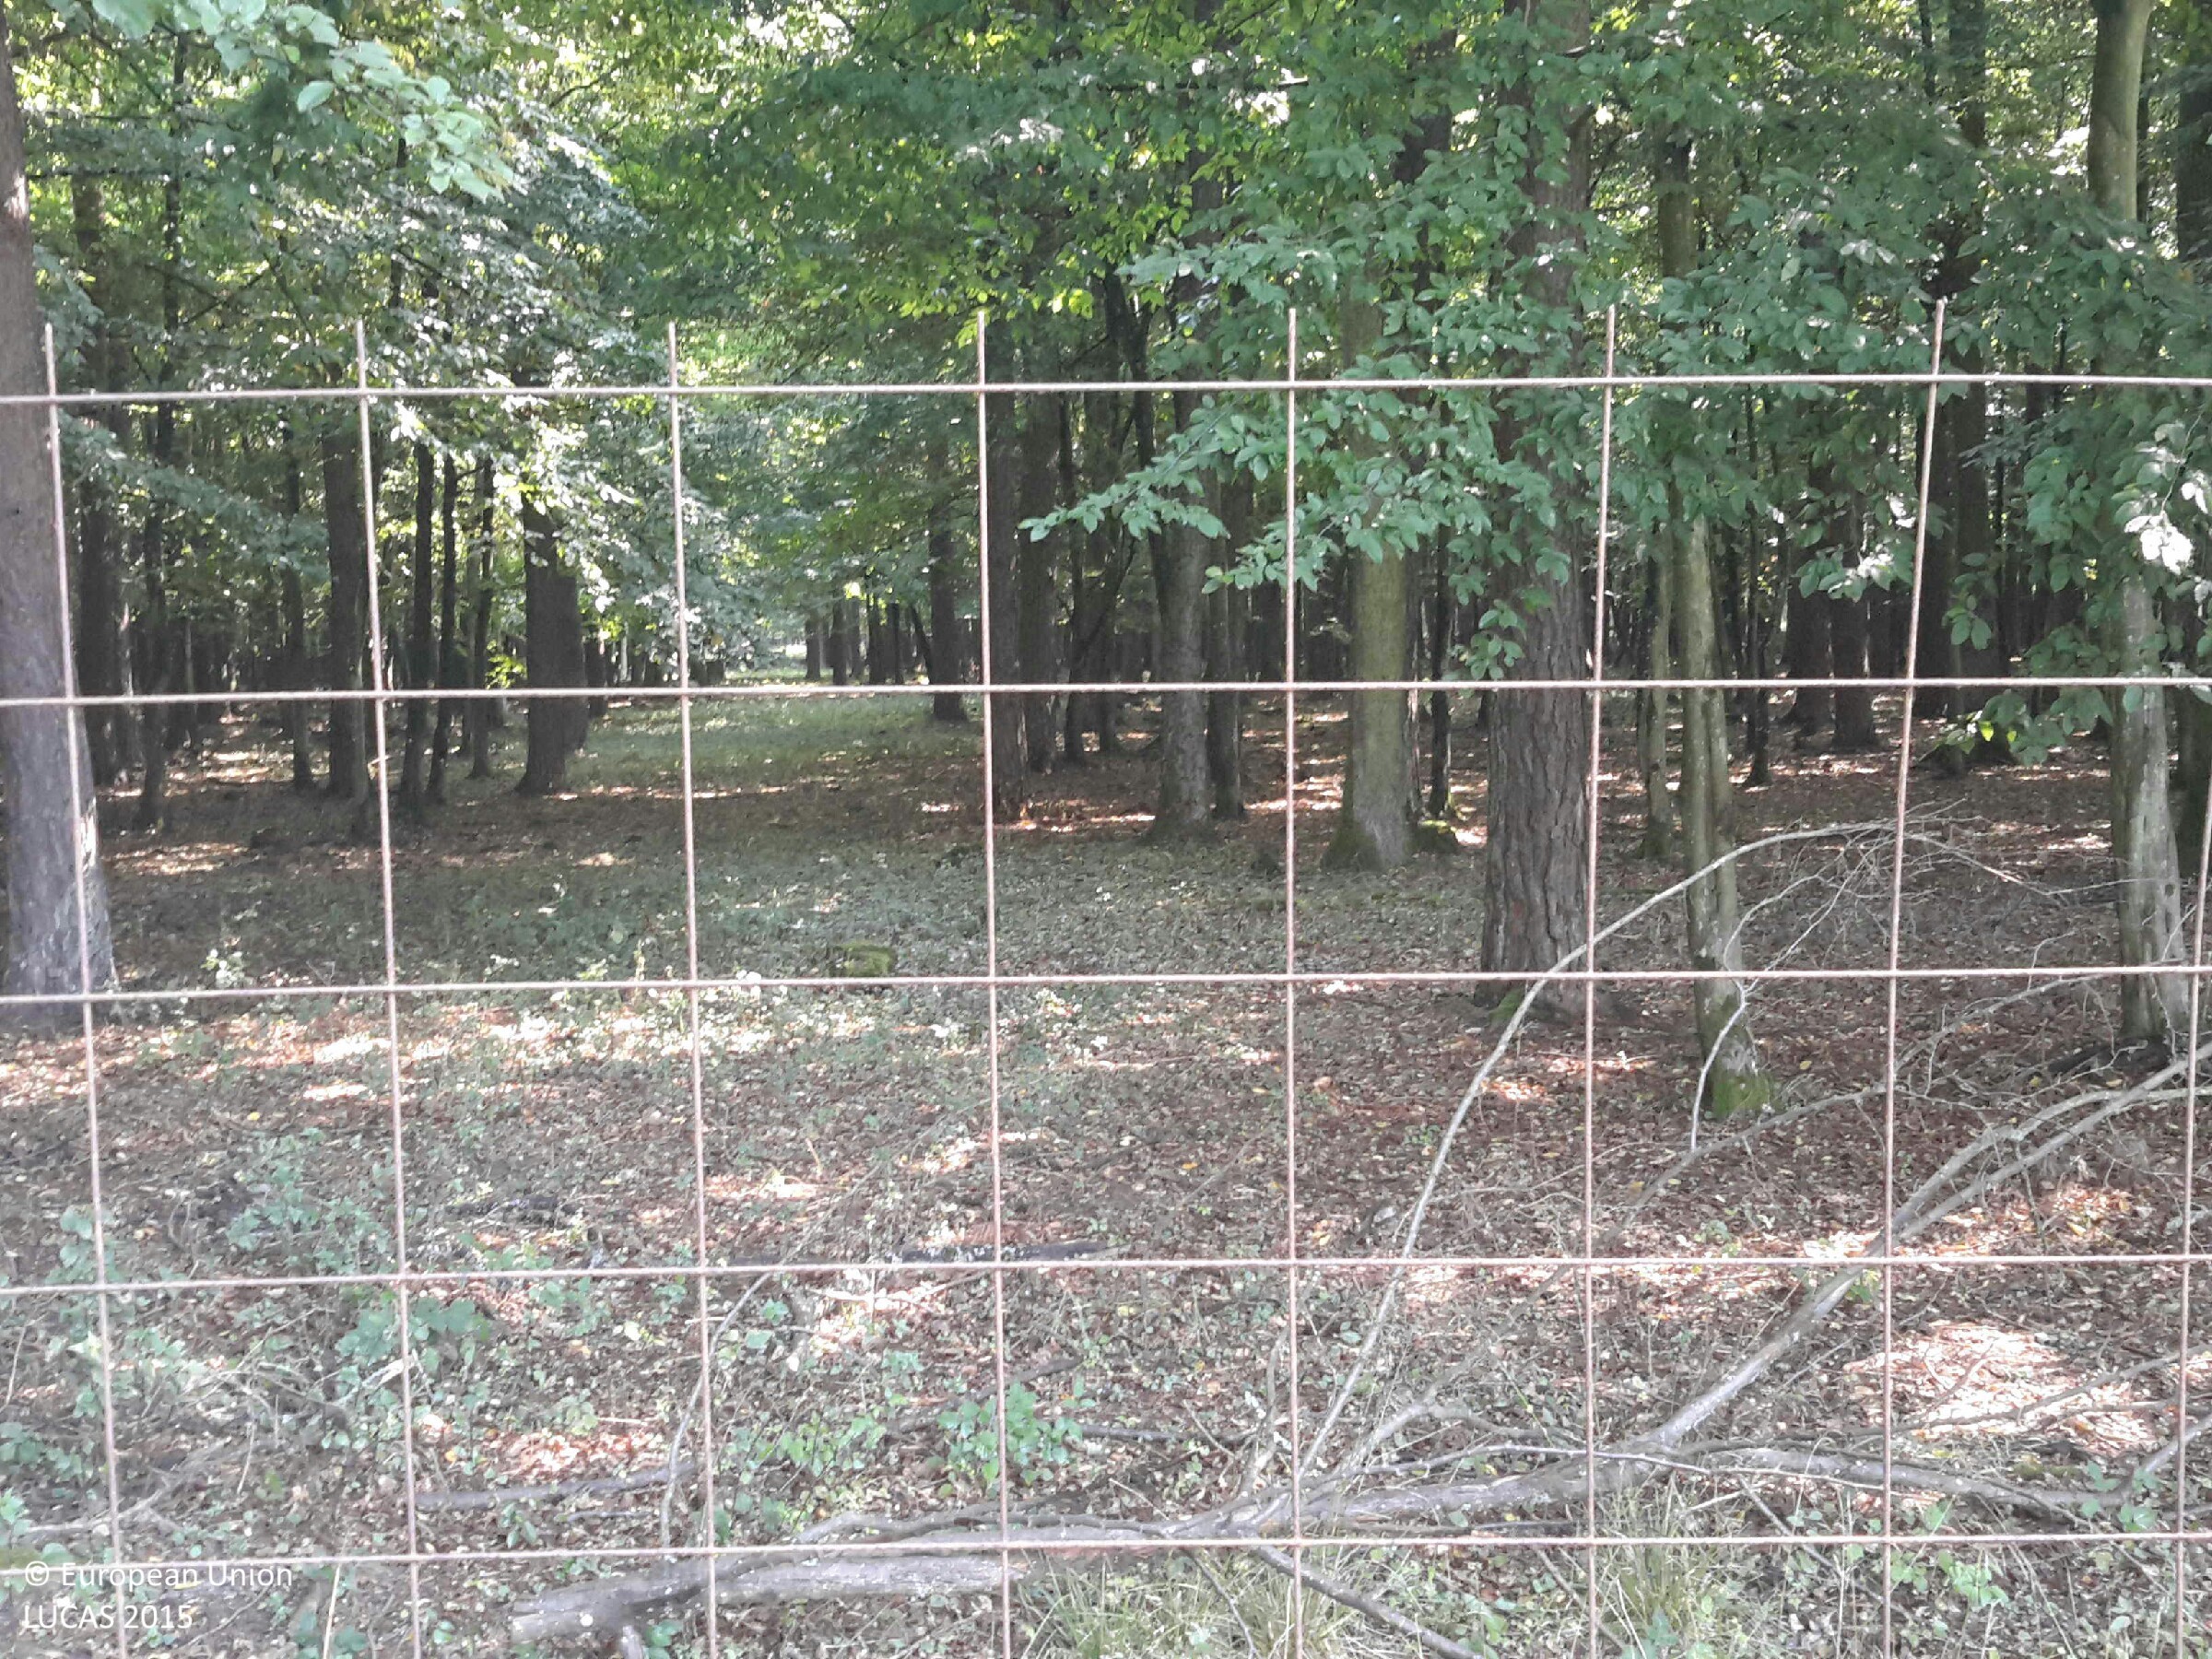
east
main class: Woodland
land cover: Broadleaved woodland
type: beech forest
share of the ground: > 75 %
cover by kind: broadleaved forest trees 90 %, herbaceous plants 10 %
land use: Forestry
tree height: > 5 m
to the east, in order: Broadleaved woodland
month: August
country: HU
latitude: 47.1093
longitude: 16.5260
